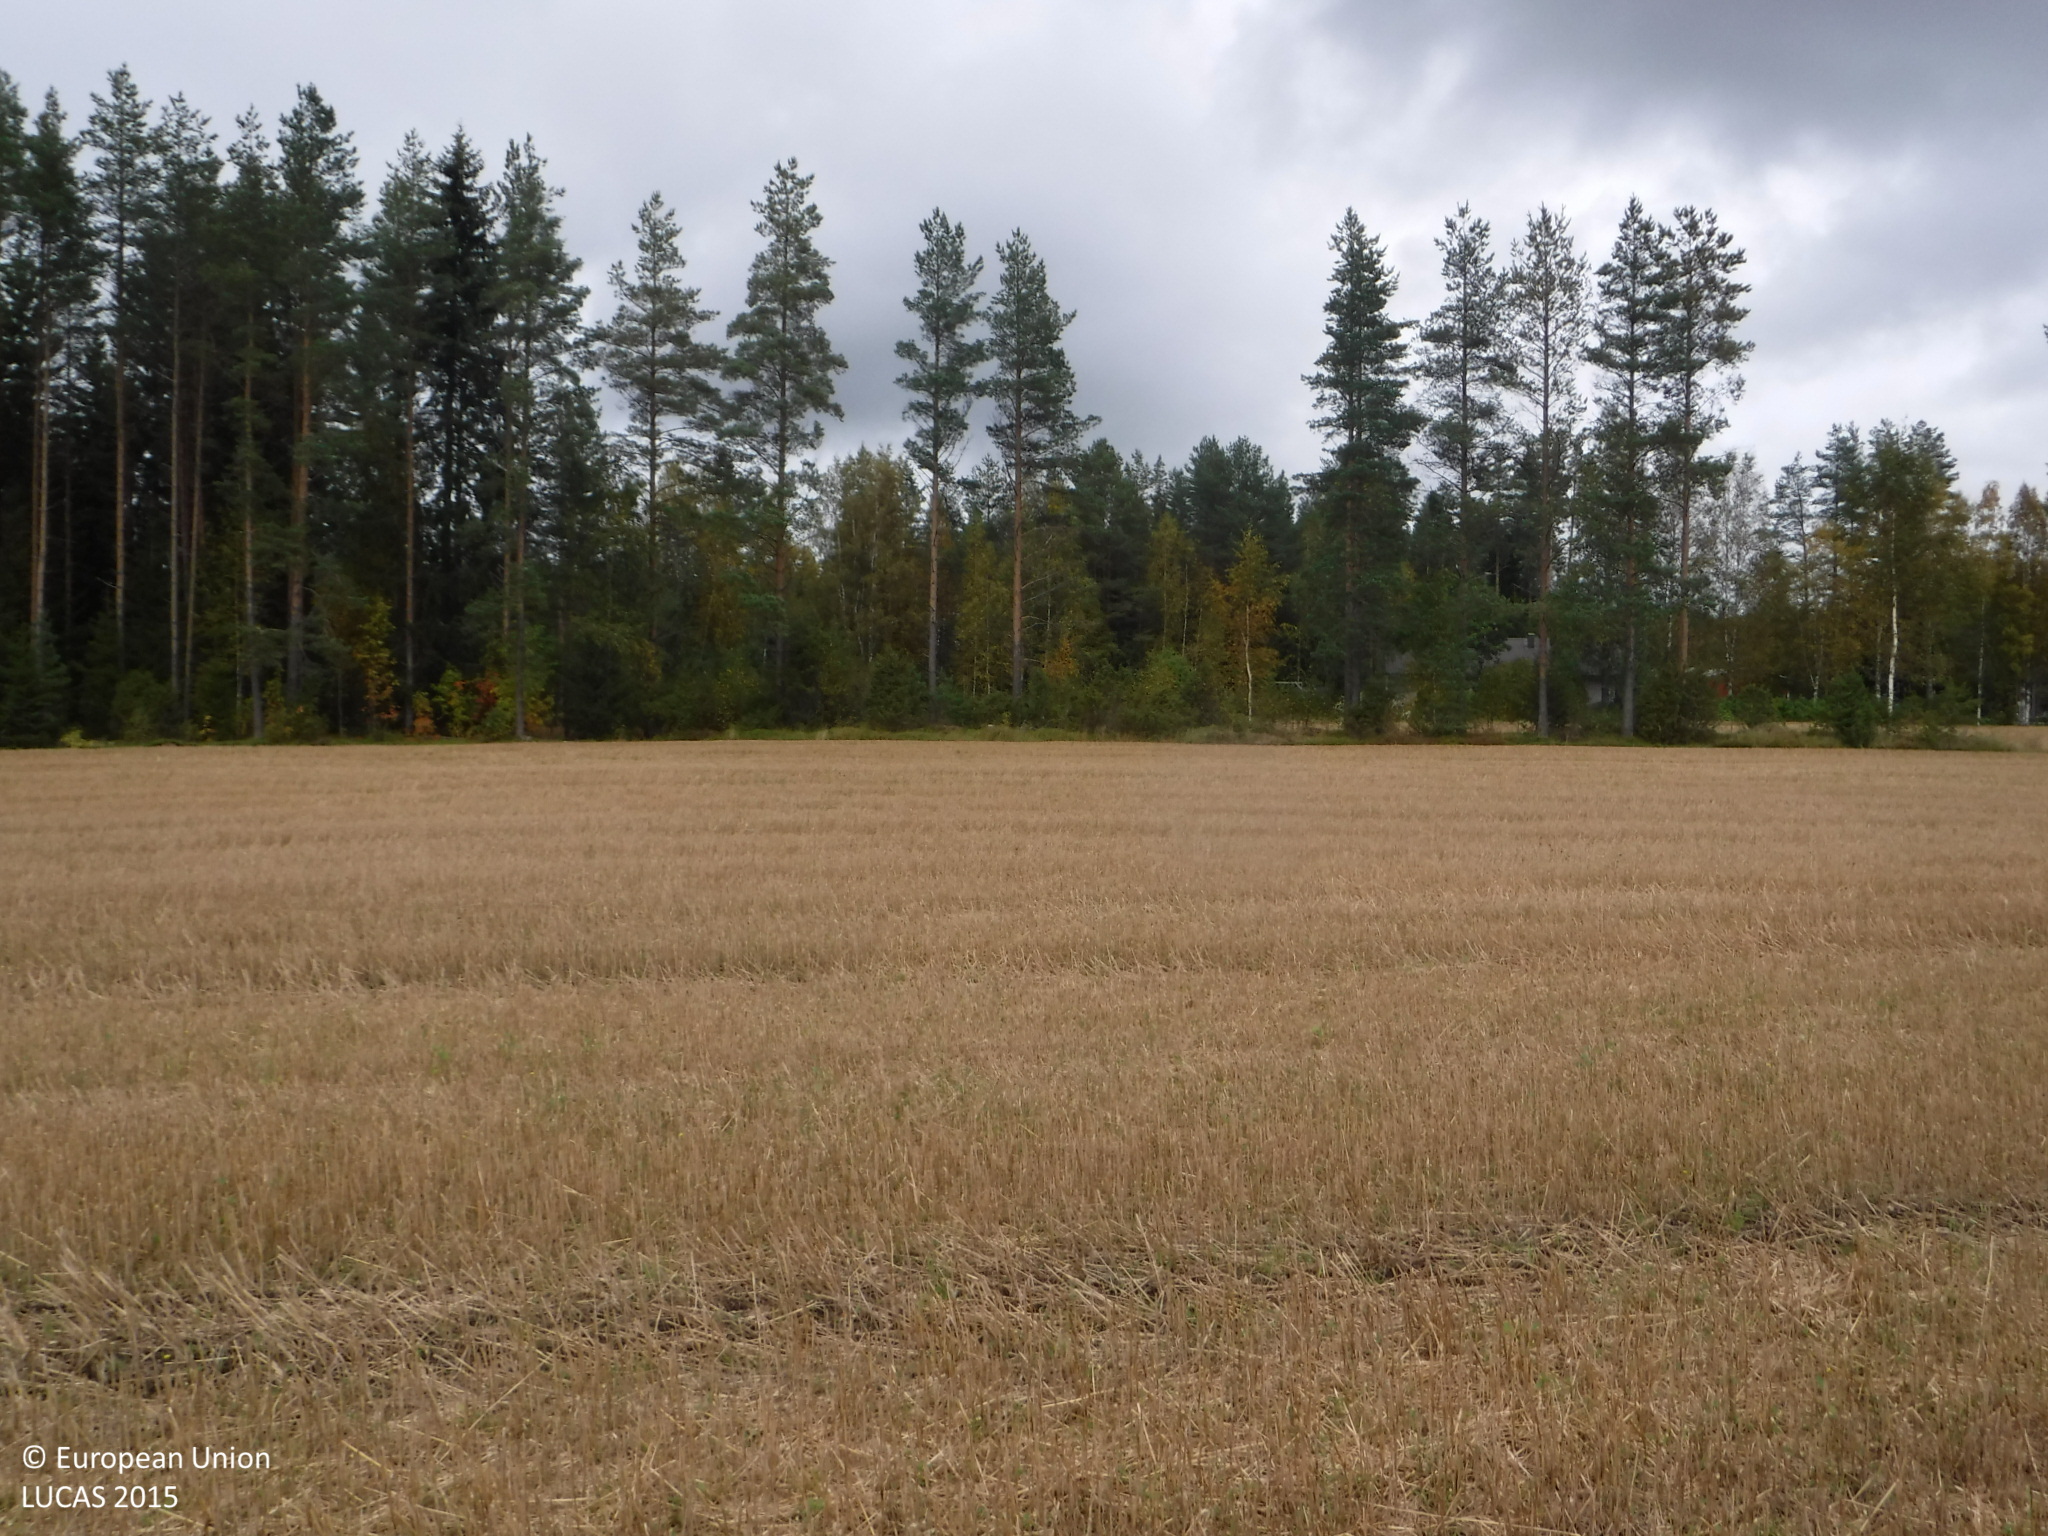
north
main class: Cropland
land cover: Barley
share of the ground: > 75 %
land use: Agriculture (excluding fallow land and kitchen gardens)
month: September
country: FI
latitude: 62.0206
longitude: 22.2267
